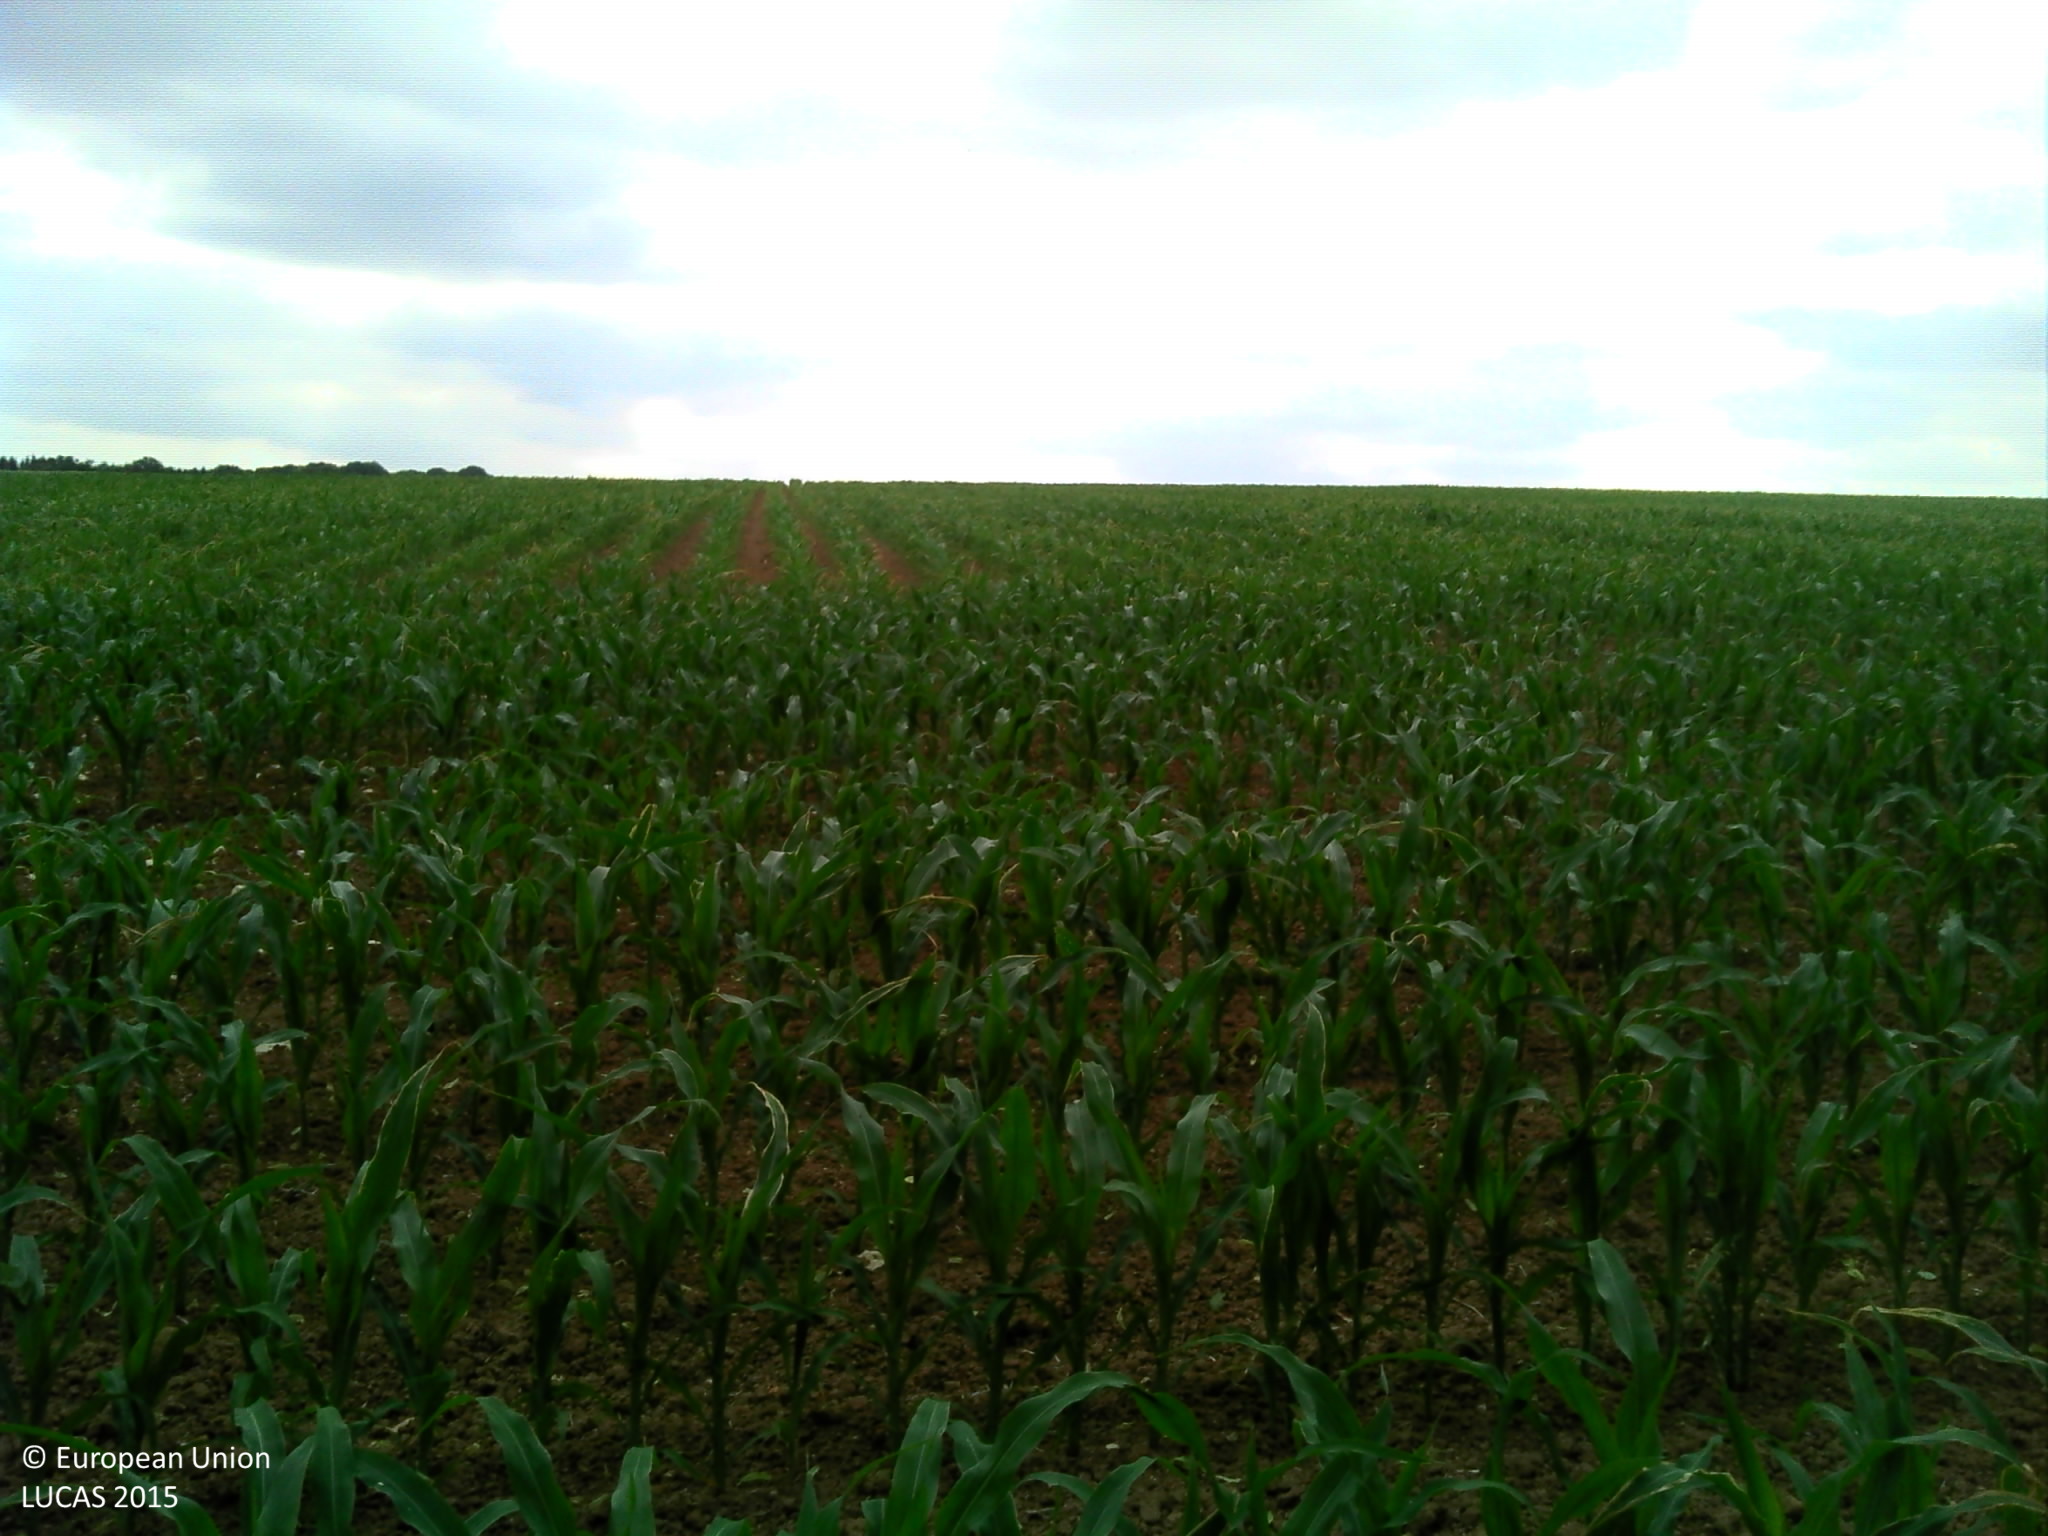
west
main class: Cropland
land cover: Maize
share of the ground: 50 - 75 %
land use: Agriculture (excluding fallow land and kitchen gardens)
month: June
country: FR
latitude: 47.4768
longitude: 6.2994
